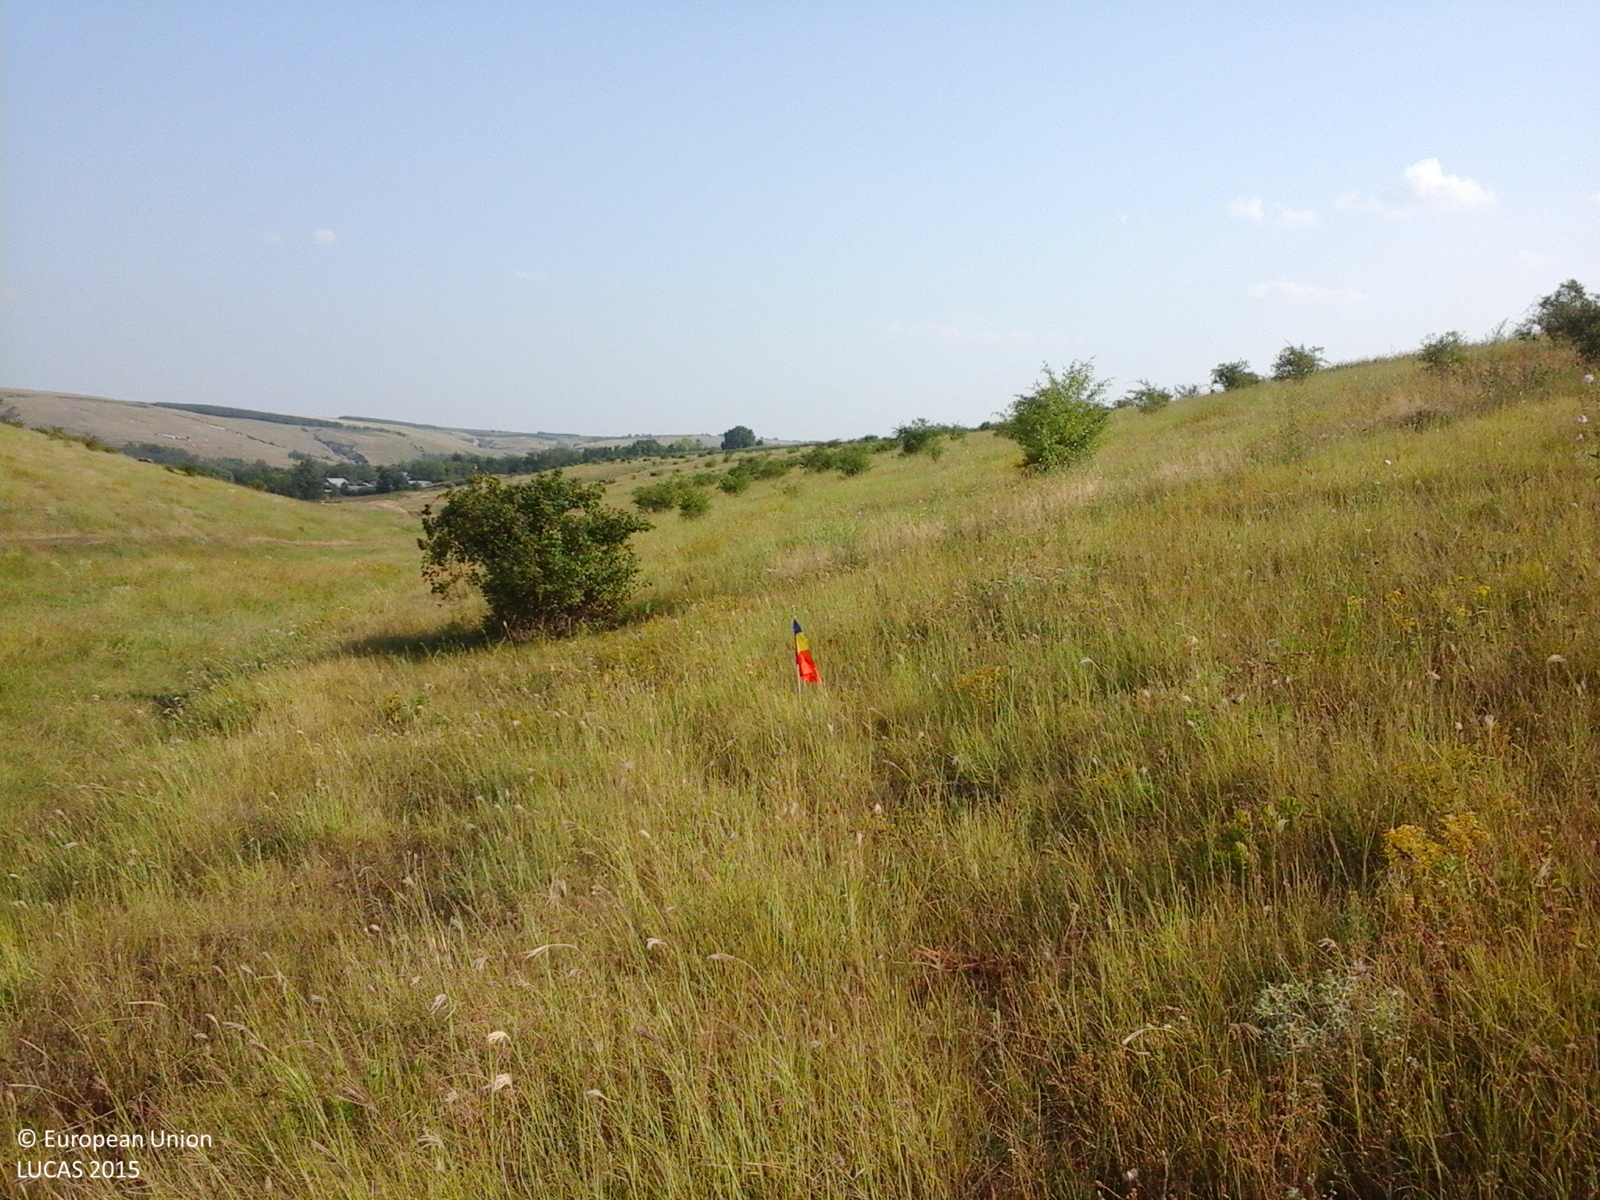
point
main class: Grassland
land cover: Grassland with sparse tree/shrub cover
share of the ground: > 75 %
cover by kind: herbaceous plants 90 %, broadleaved forest trees 5 %, shrubs 5 %
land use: Agriculture (excluding fallow land and kitchen gardens)
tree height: < 5 m
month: July
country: RO
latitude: 45.9386
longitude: 27.6390
